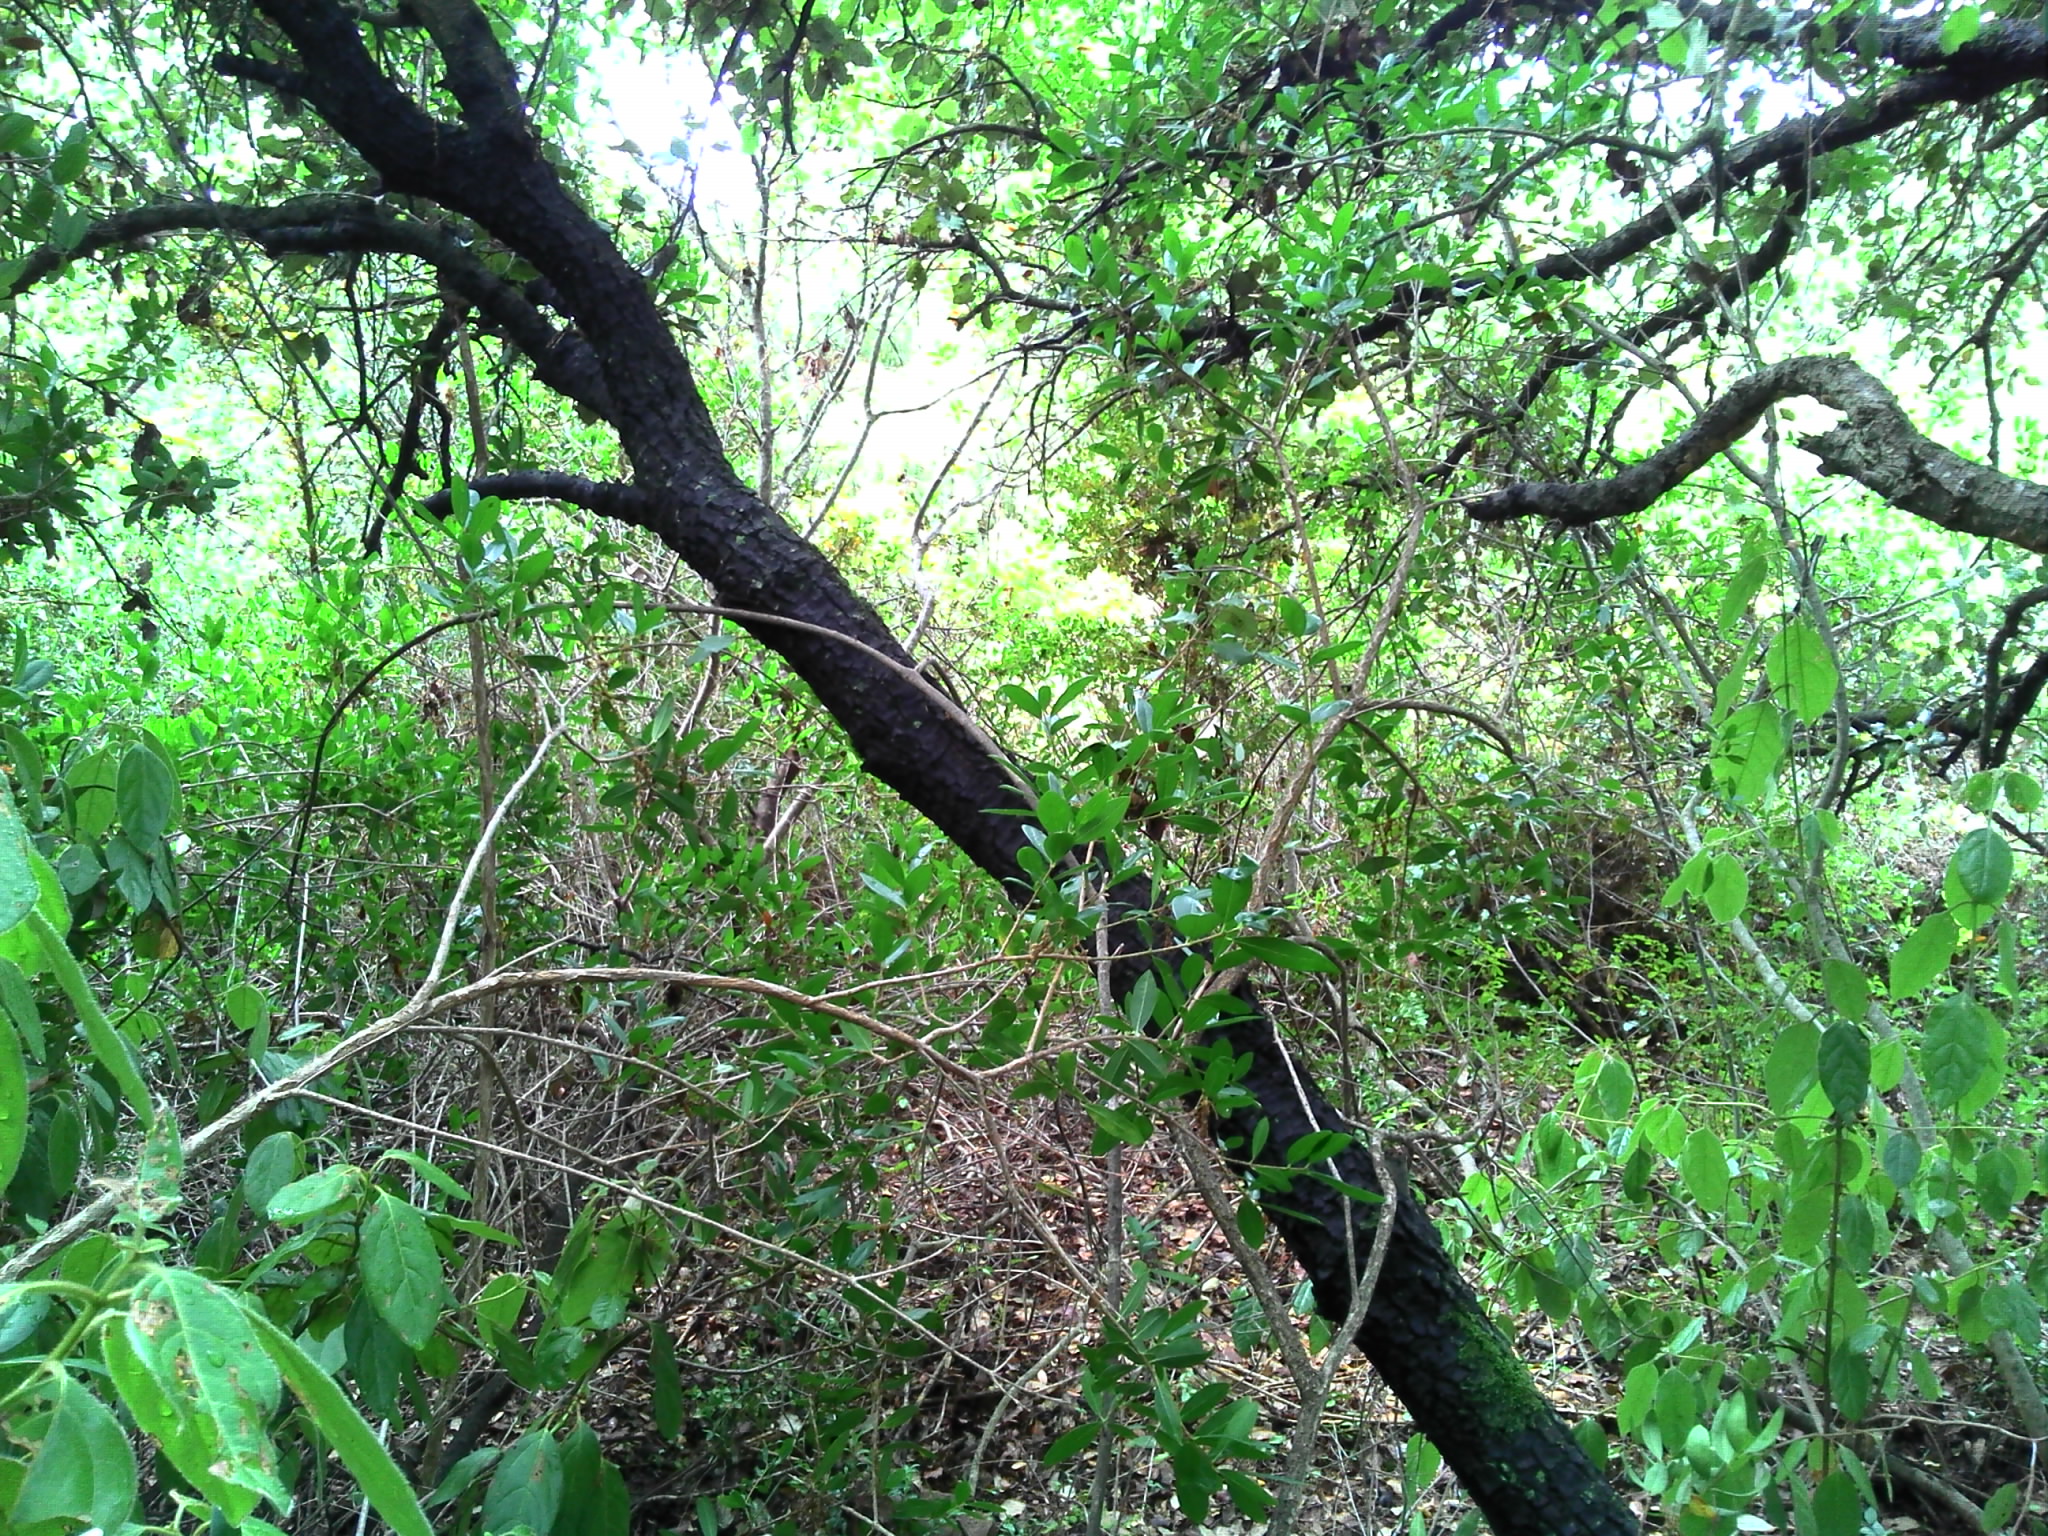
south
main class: Woodland
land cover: Broadleaved woodland
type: broadleaved evergreen forest
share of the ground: > 75 %
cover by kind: broadleaved forest trees 60 %, consolidated bare surface 20 %, shrubs 10 %, herbaceous plants 10 %
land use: Semi-natural and natural areas not in use
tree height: > 5 m
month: August
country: FR
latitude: 44.1220
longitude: 4.6470
